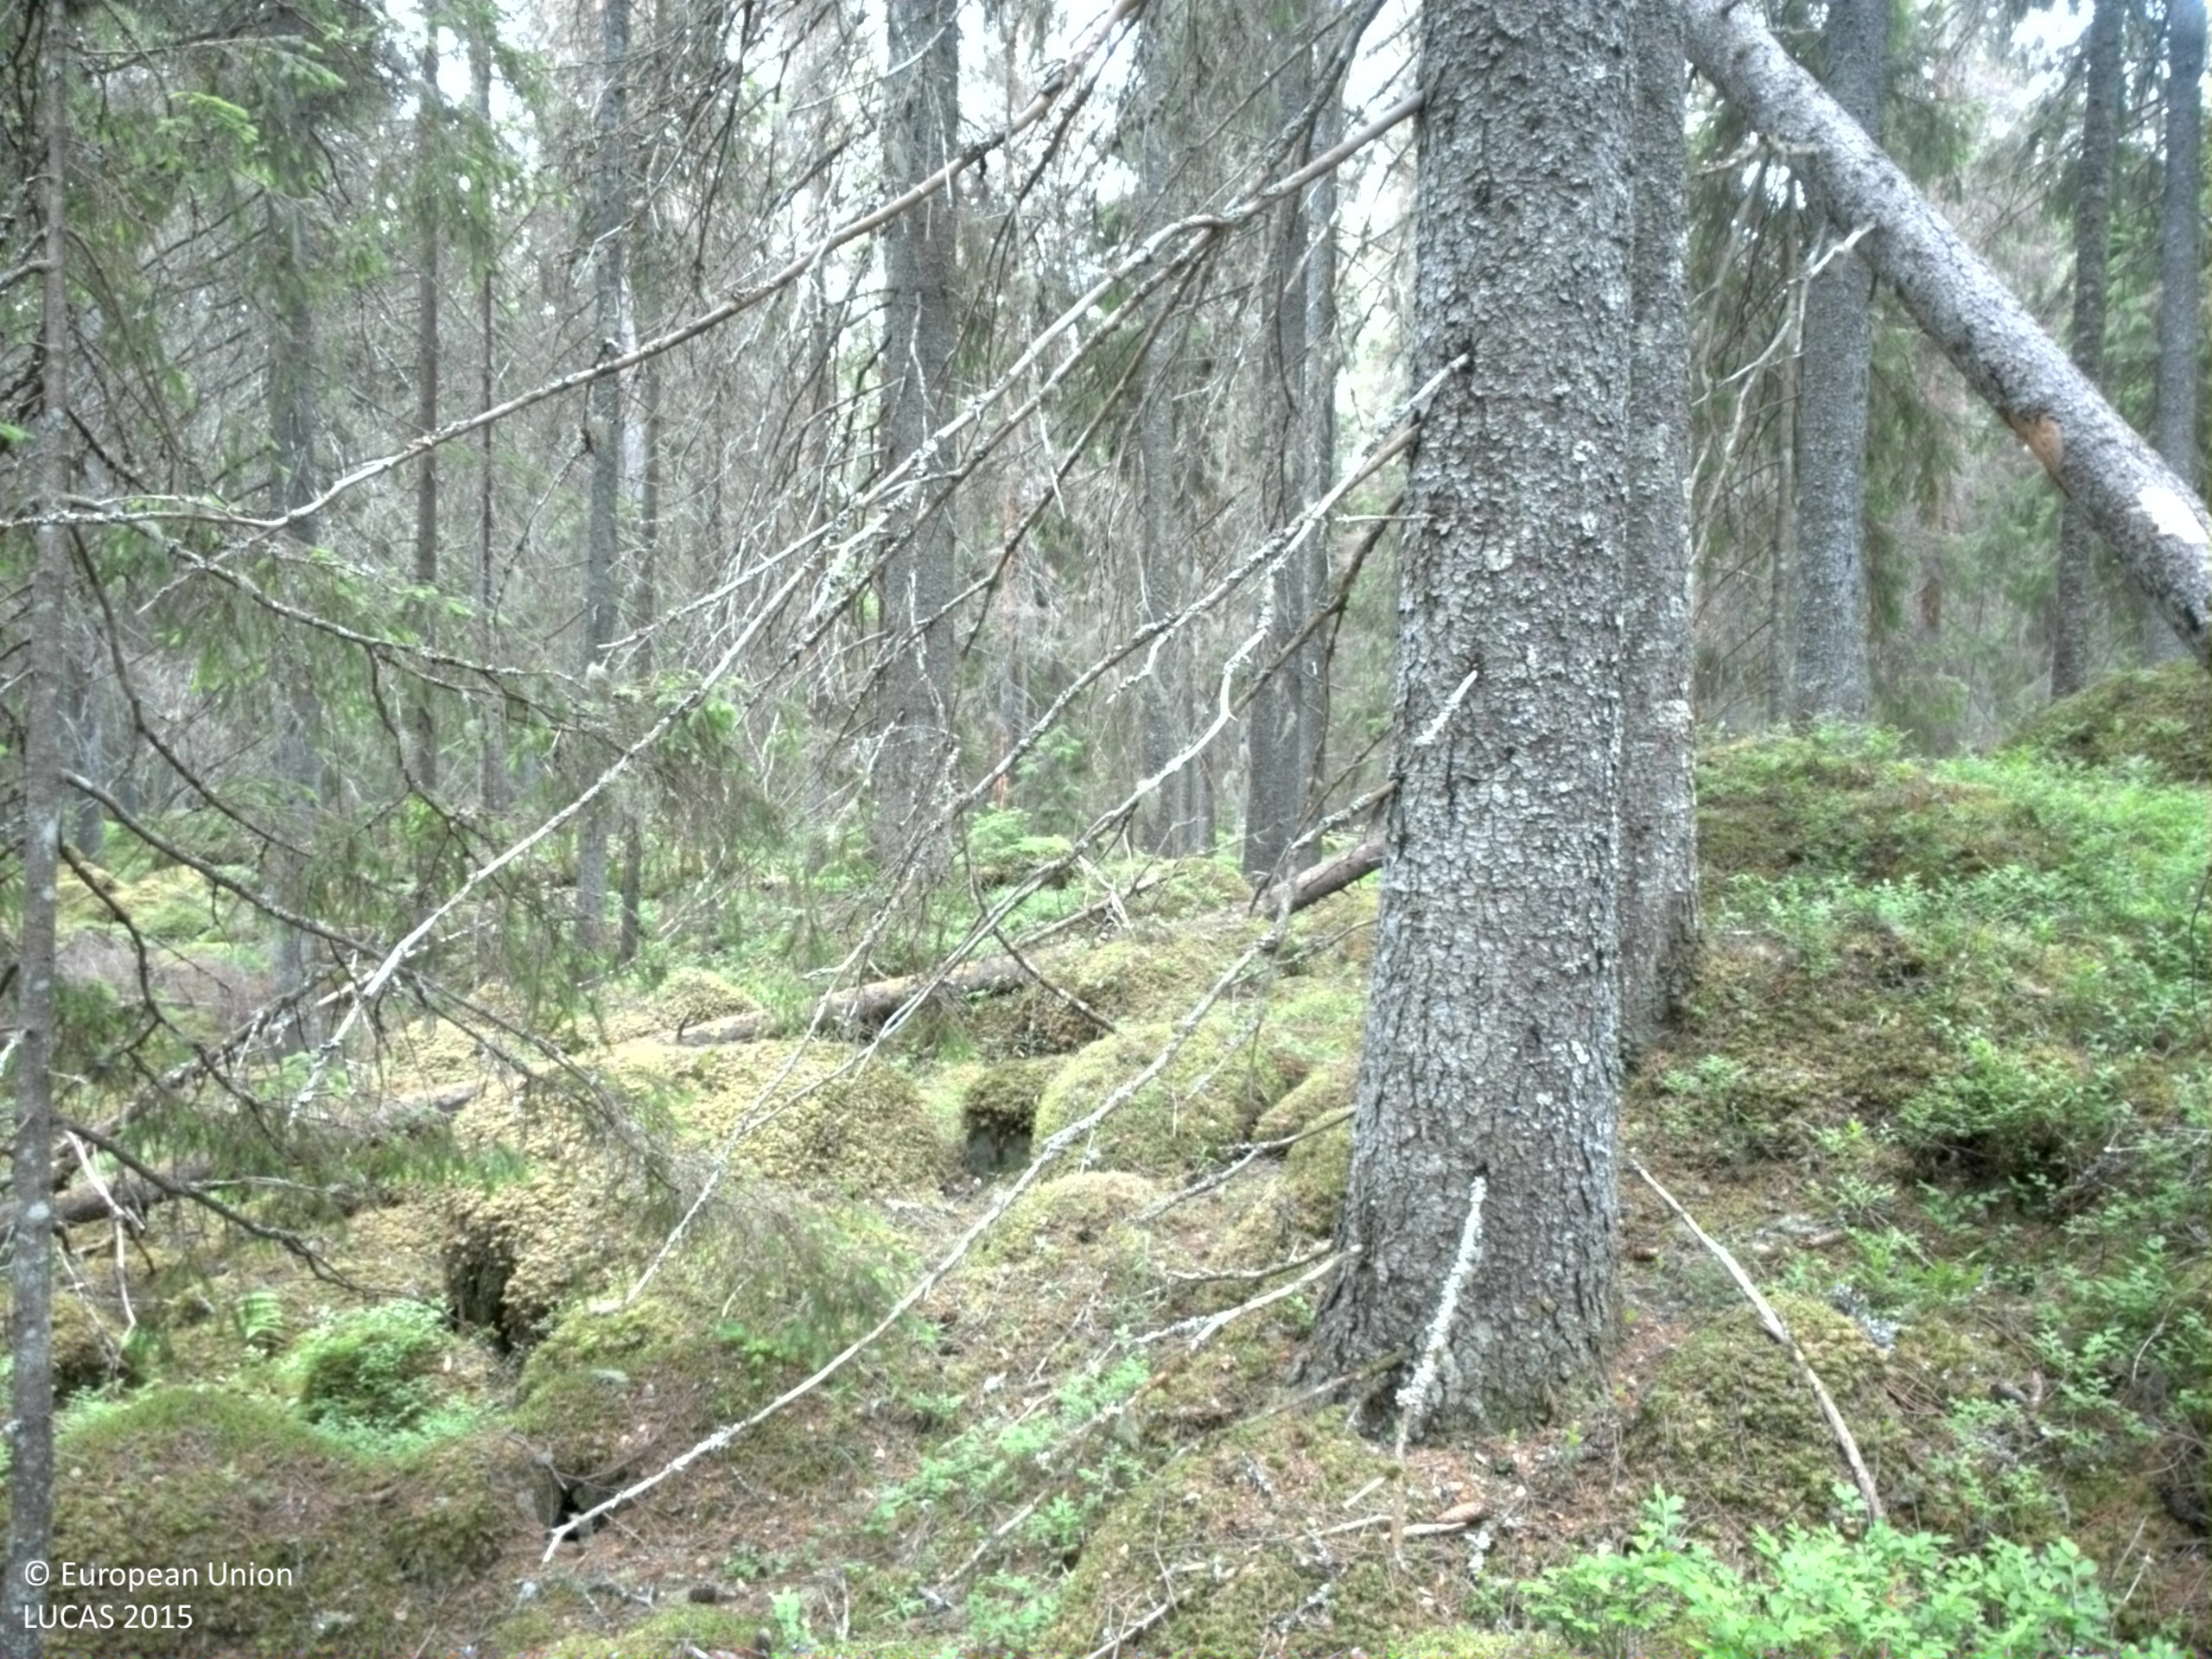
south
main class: Woodland
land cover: Spruce dominated coniferous woodland
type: boreal forest
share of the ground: > 75 %
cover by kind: coniferous forest trees 75 %, shrubs 10 %, lichens and mosses 10 %, broadleaved forest trees 5 %
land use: Forestry
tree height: > 5 m
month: June
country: SE
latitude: 60.3109
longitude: 17.7577
